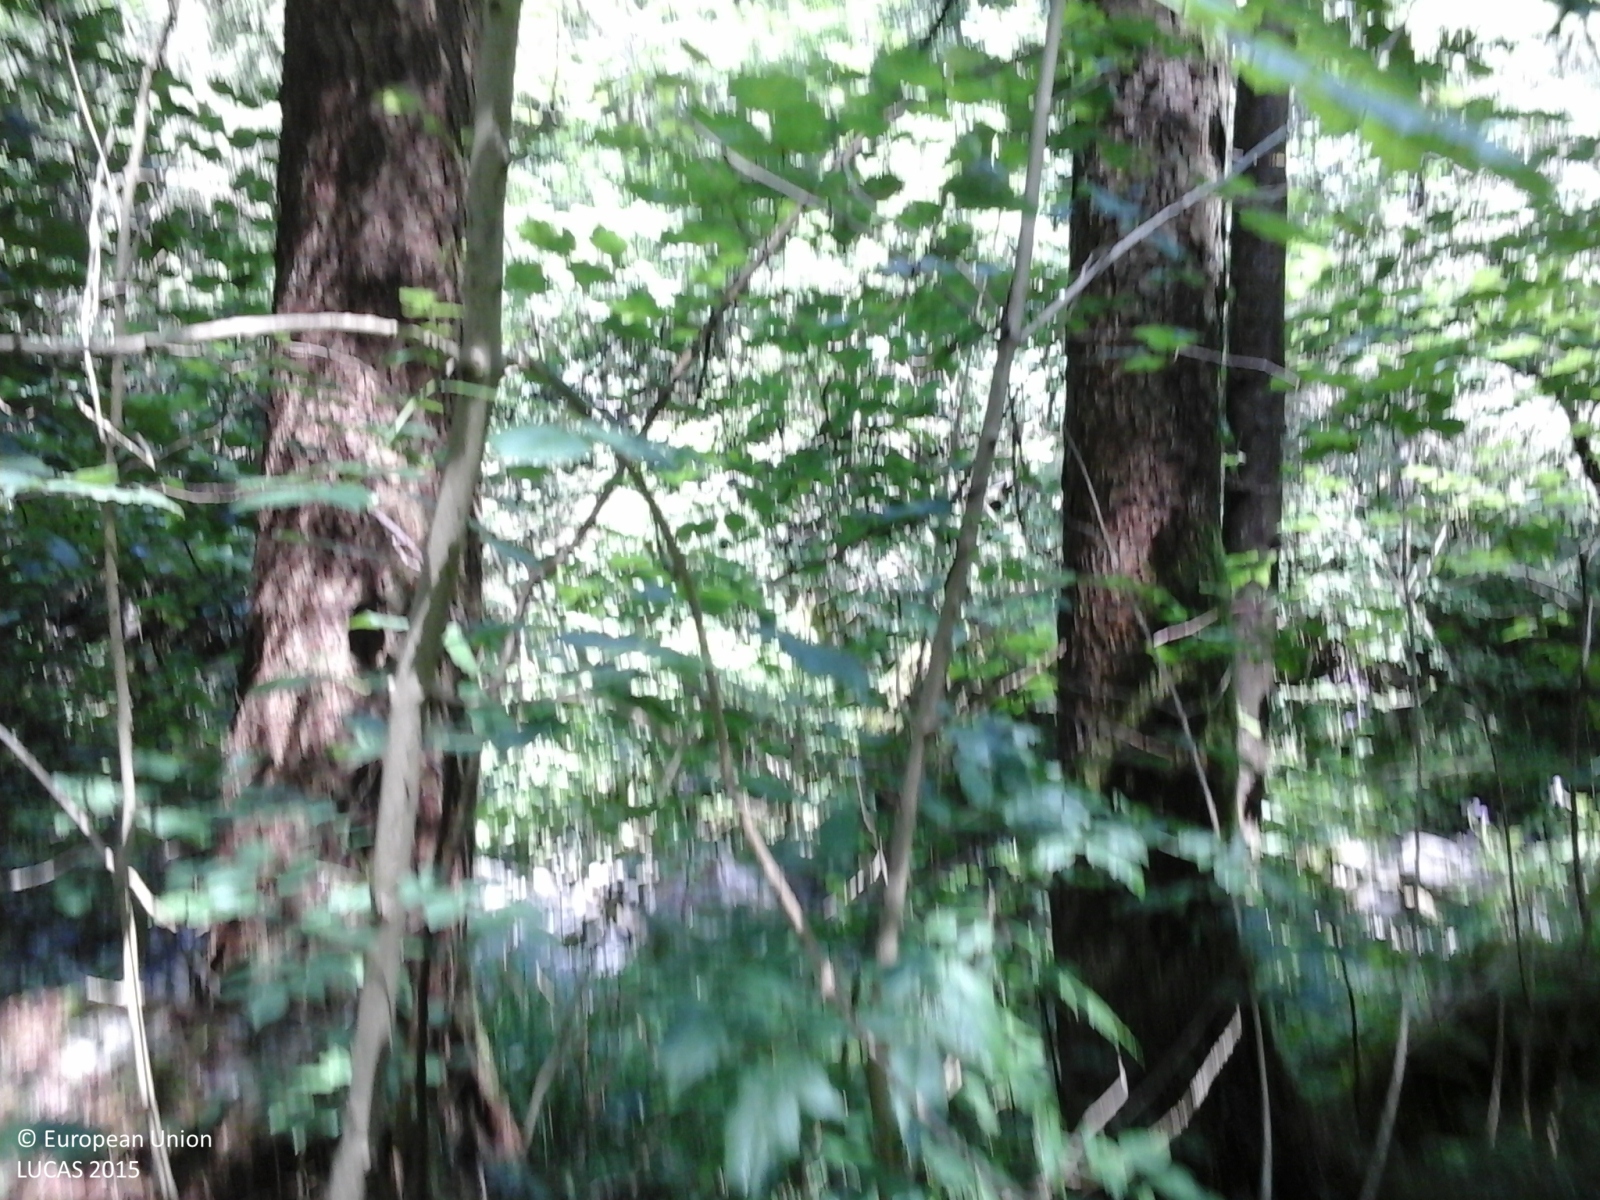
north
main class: Woodland
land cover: Spruce dominated mixed woodland
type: alpine coniferous forest
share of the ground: > 75 %
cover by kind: coniferous forest trees 75 %, broadleaved forest trees 25 %
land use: Semi-natural and natural areas not in use
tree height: > 5 m
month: July
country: IT
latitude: 45.9728
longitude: 10.1160
